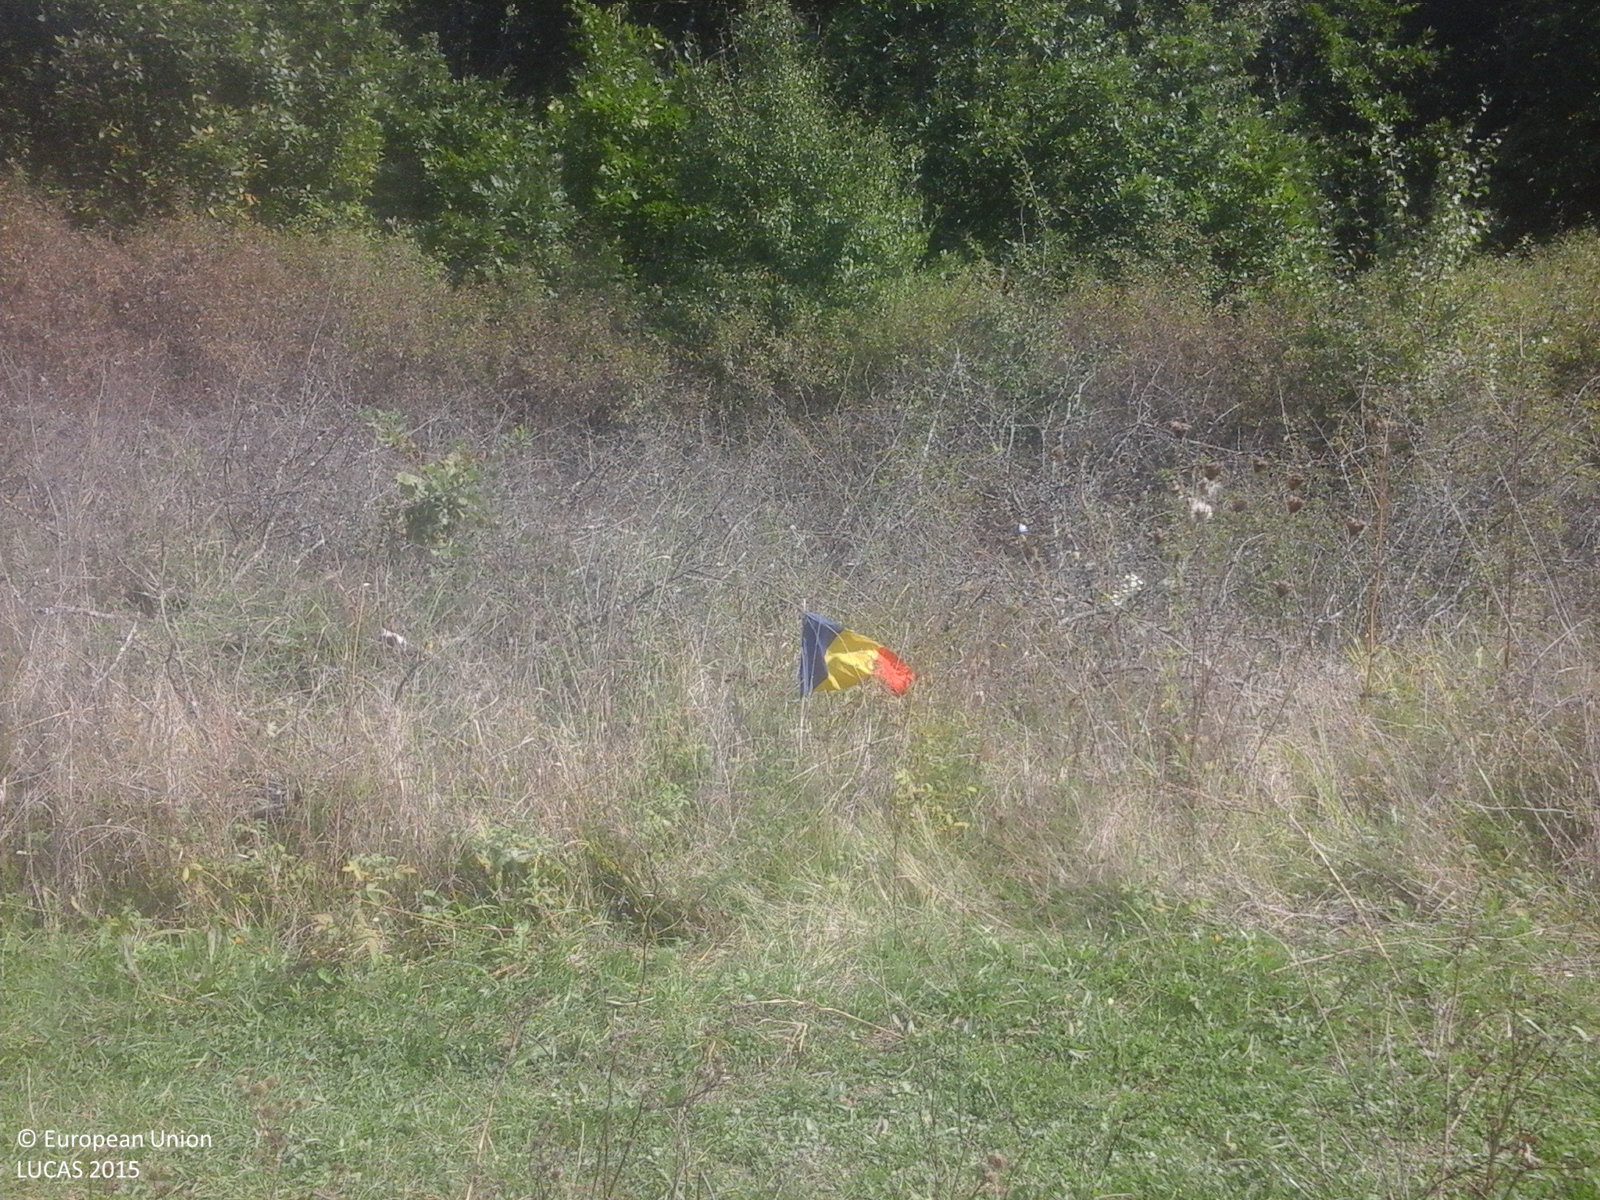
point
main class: Grassland
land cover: Spontaneously vegetated surfaces
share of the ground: > 75 %
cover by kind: herbaceous plants 100 %
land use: Semi-natural and natural areas not in use
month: September
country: RO
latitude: 46.9316
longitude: 23.2130
